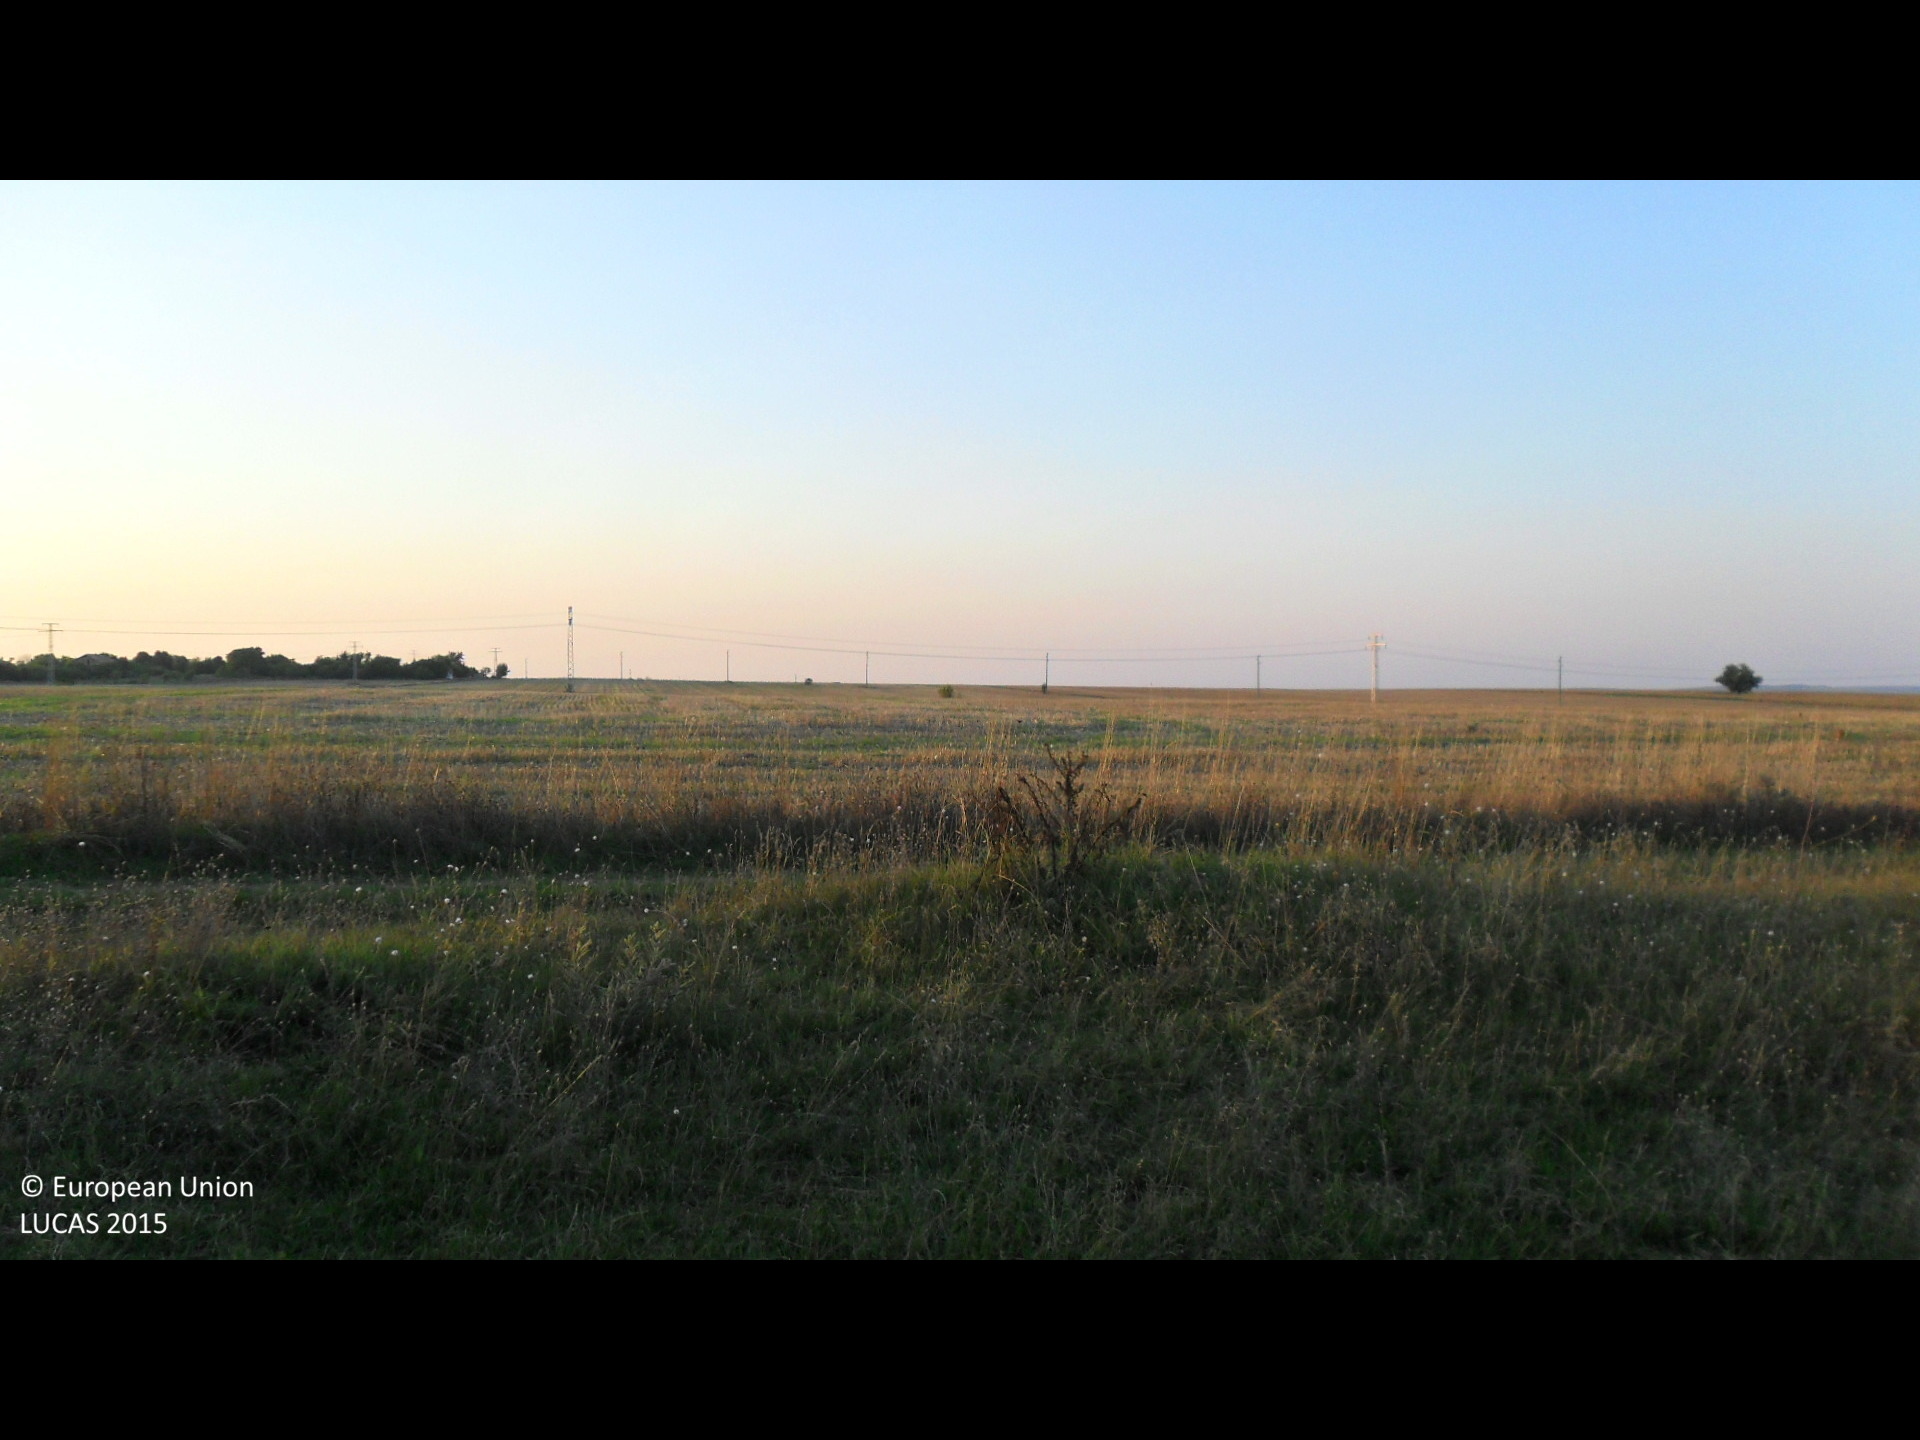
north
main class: Grassland
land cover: Grassland with sparse tree/shrub cover
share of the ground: > 75 %
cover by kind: herbaceous plants 90 %, broadleaved forest trees 5 %, shrubs 5 %
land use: Abandoned areas
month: August
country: BG
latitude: 43.2422
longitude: 26.5939
